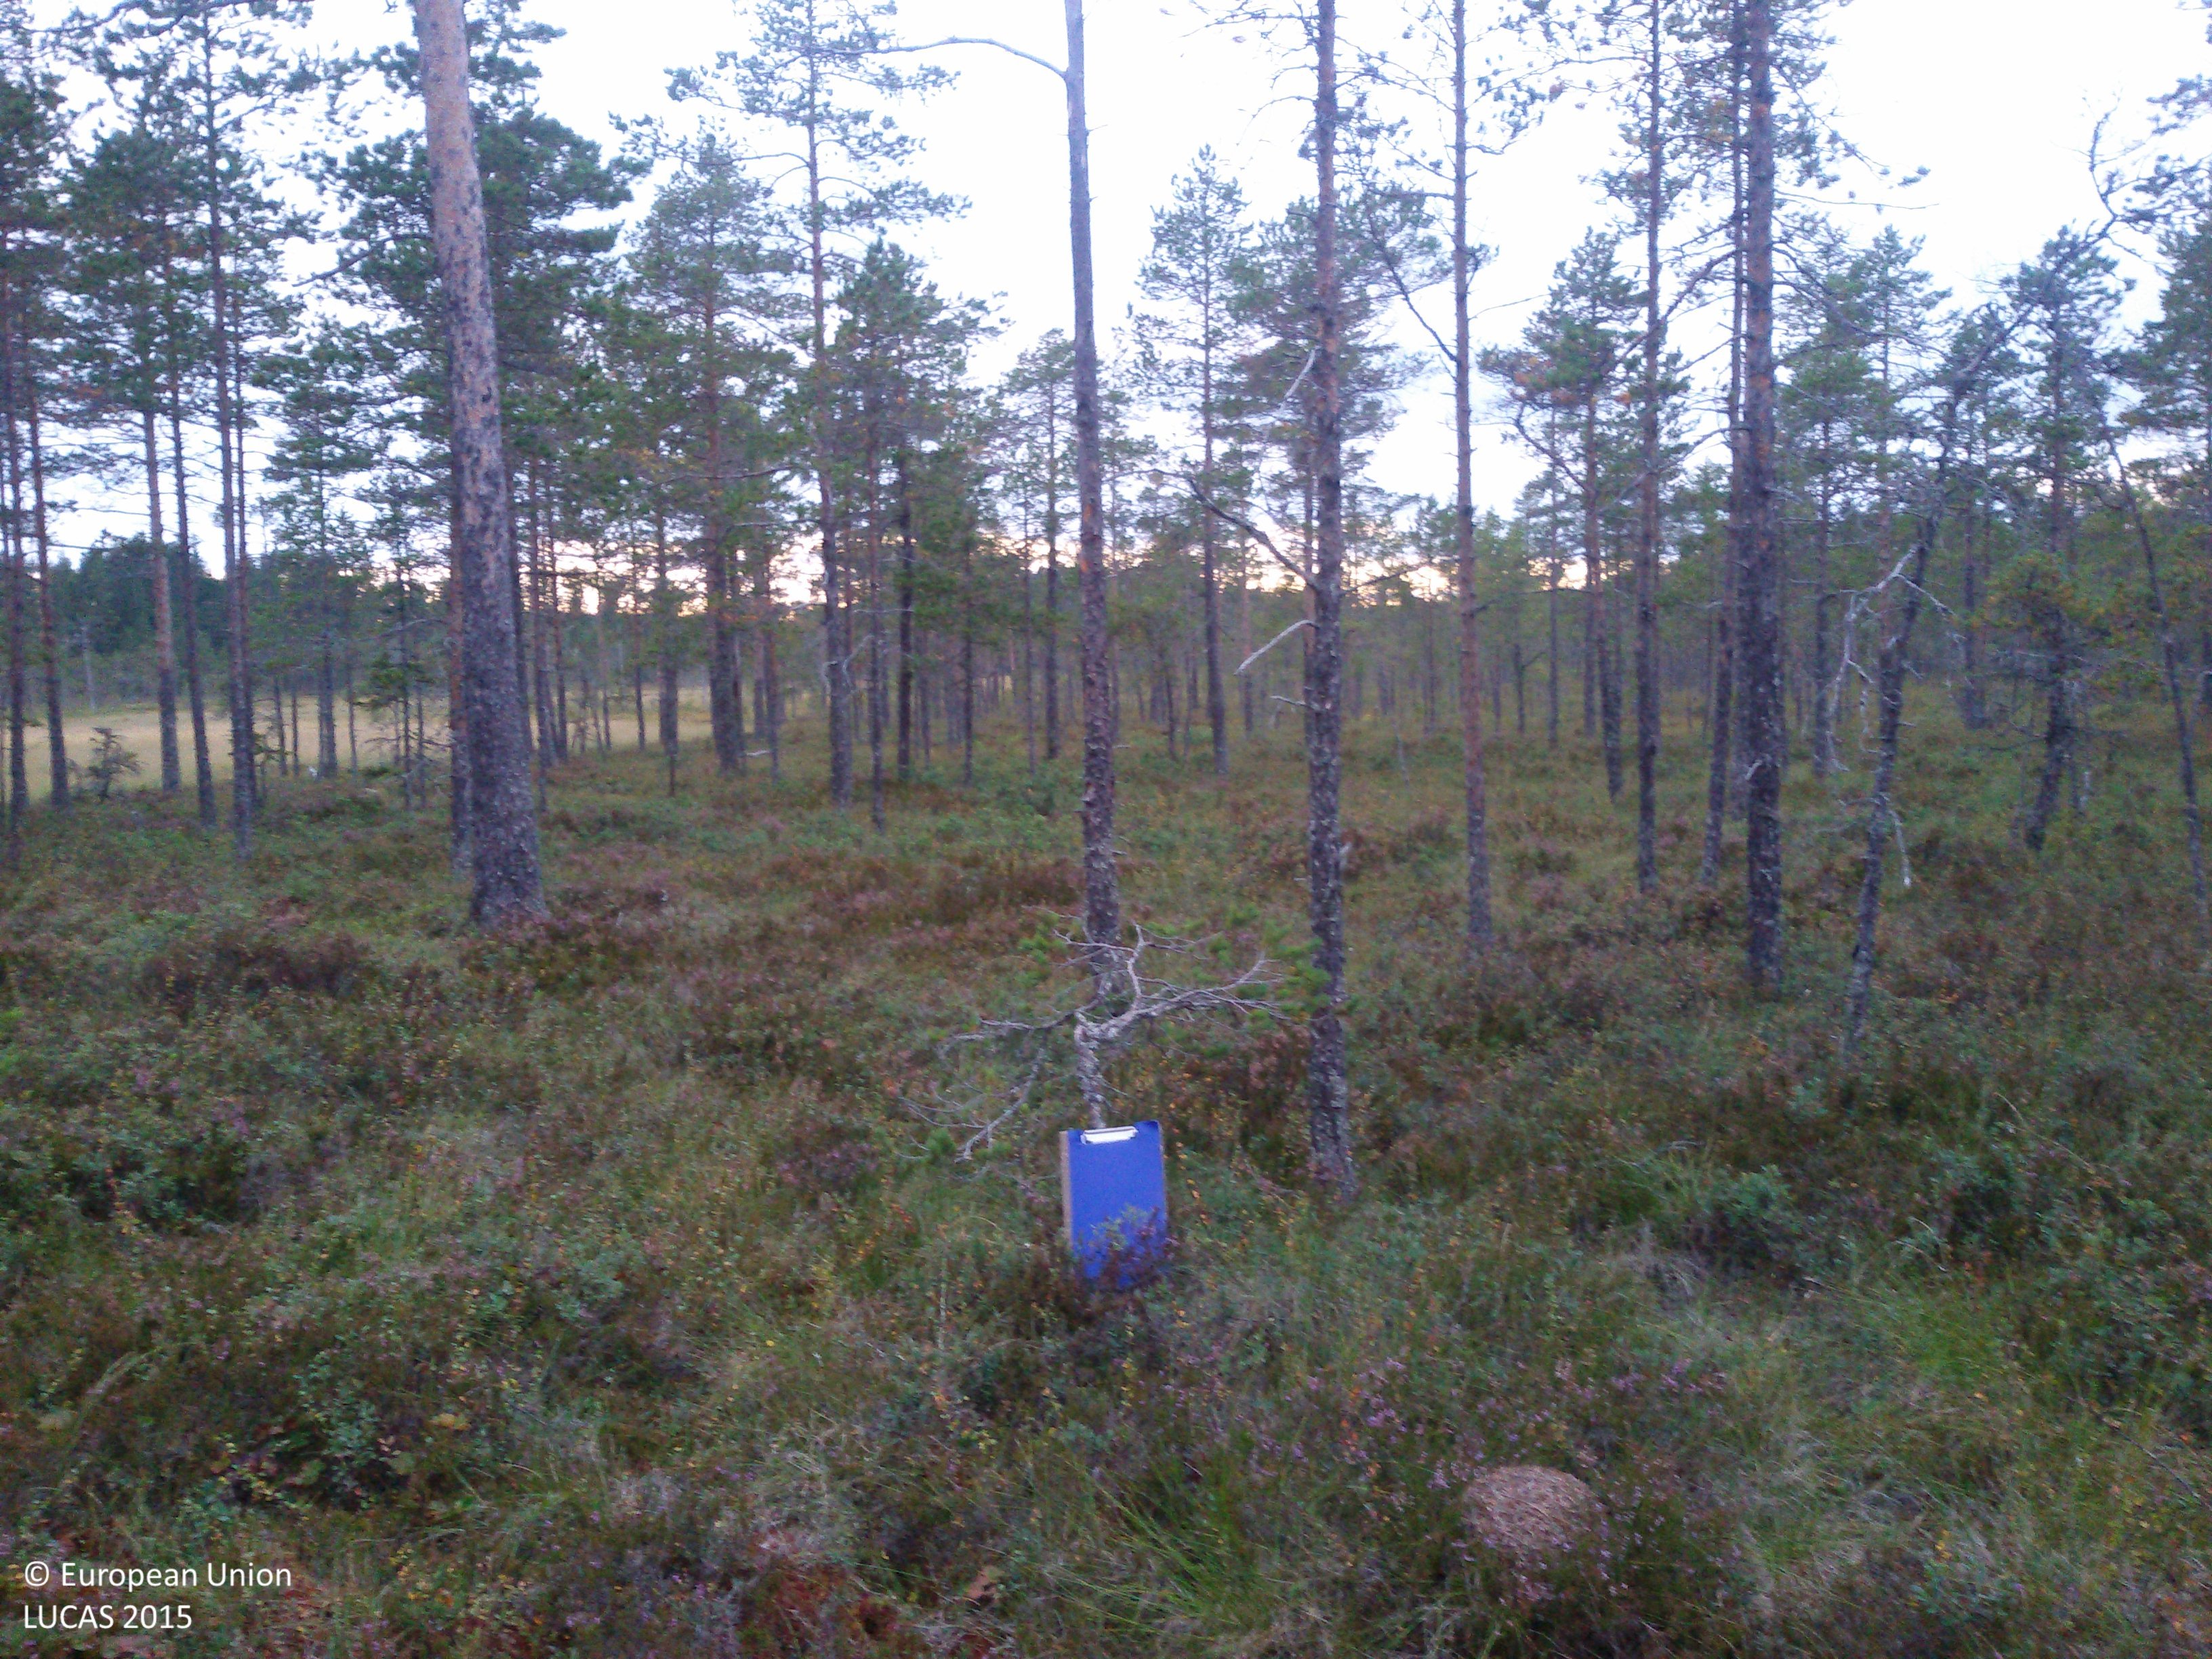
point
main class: Woodland
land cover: Pine dominated coniferous woodland
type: boreal forest
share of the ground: 50 - 75 %
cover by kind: coniferous forest trees 50 %, herbaceous plants 25 %, lichens and mosses 25 %
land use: Forestry
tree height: > 5 m
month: September
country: SE
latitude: 60.8377
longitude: 15.3401
